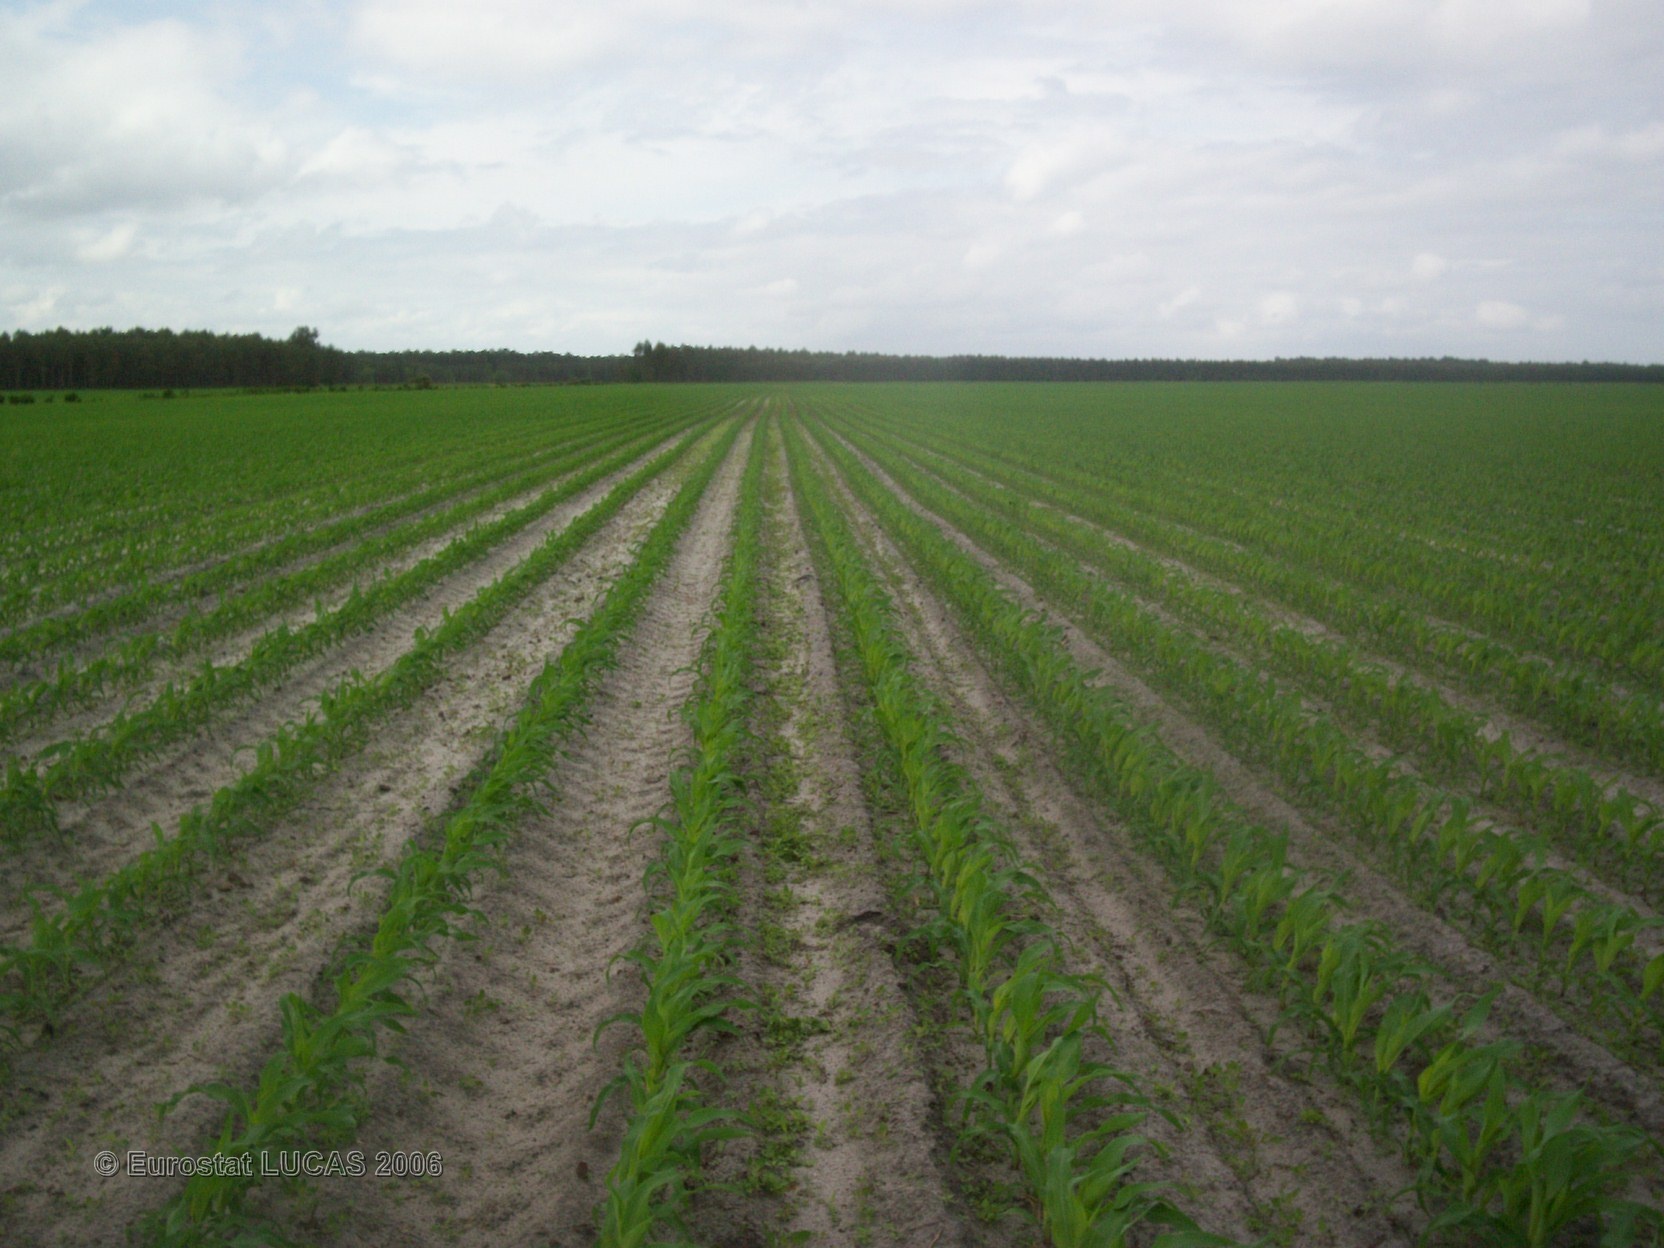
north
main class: Cropland
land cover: Maize
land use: Agriculture (excluding fallow land and kitchen gardens)
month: May
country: FR
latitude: 44.3803
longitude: -0.4953
